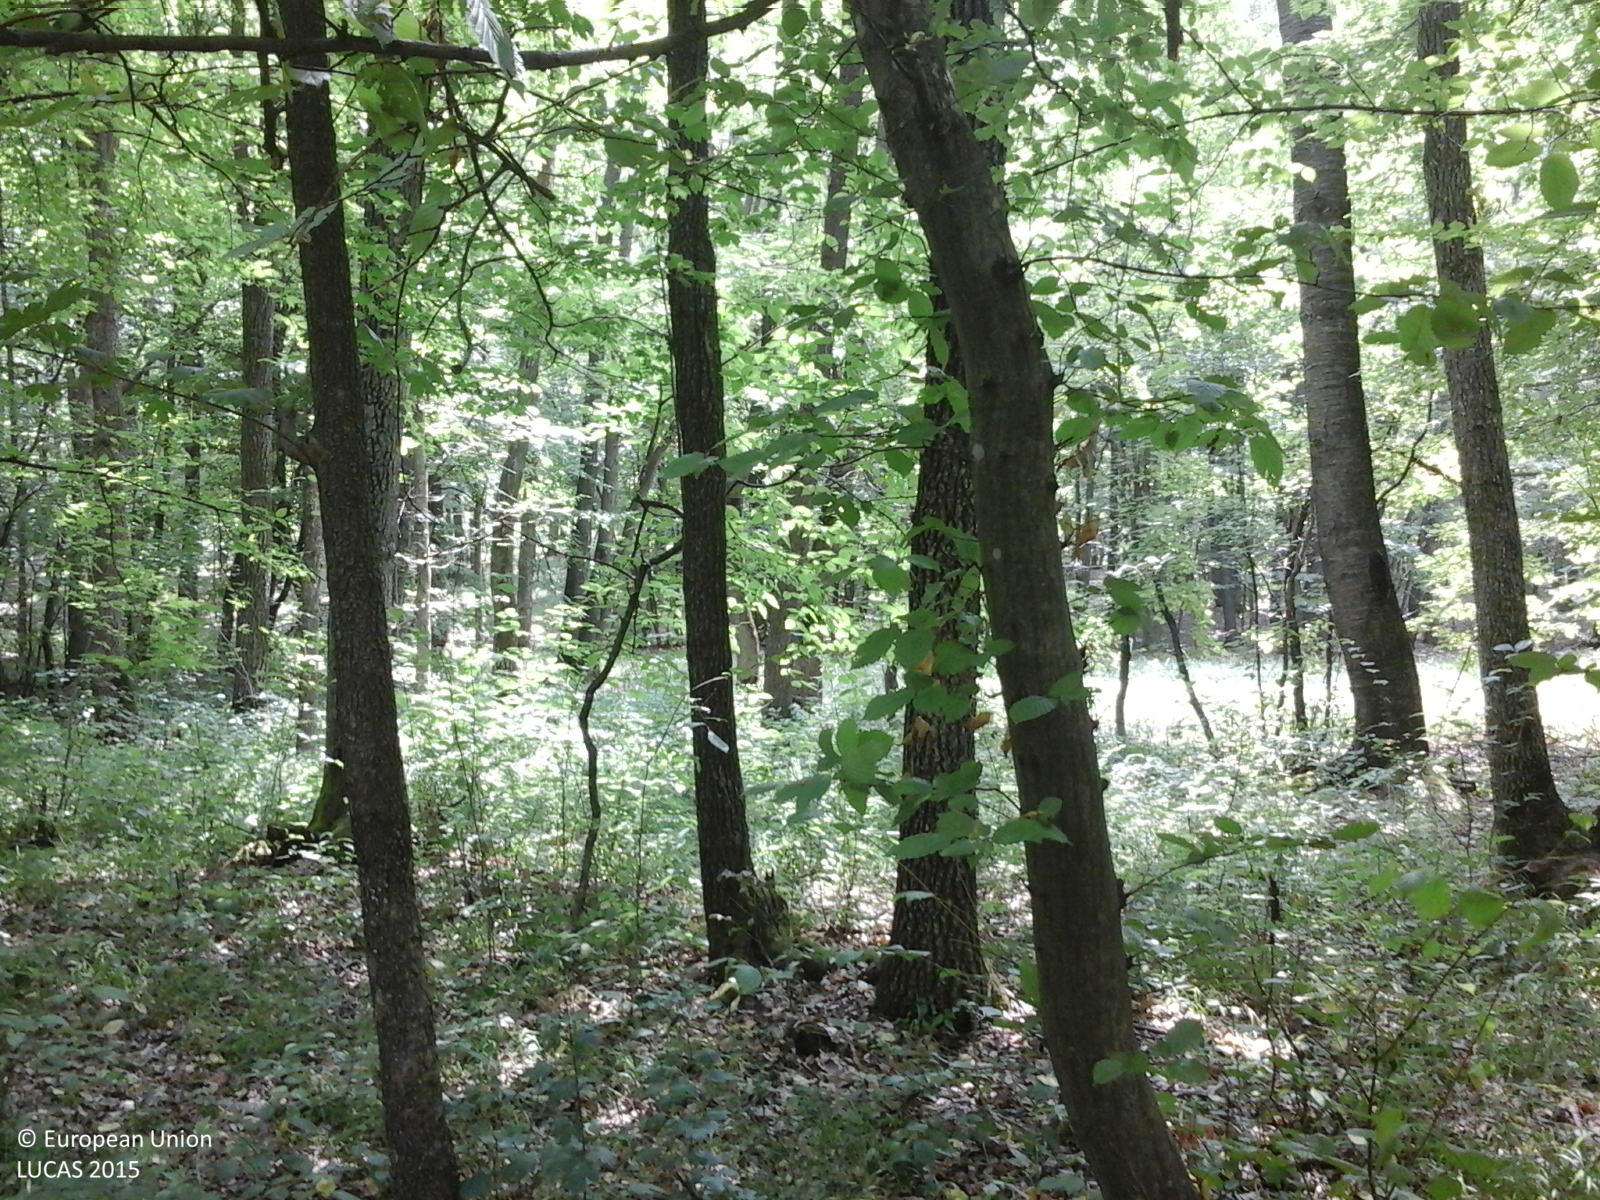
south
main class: Woodland
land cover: Broadleaved woodland
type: mesophytic deciduous forest
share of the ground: > 75 %
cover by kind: broadleaved forest trees 100 %
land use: Forestry
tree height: > 5 m
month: June
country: RO
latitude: 47.7700
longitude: 26.5445
